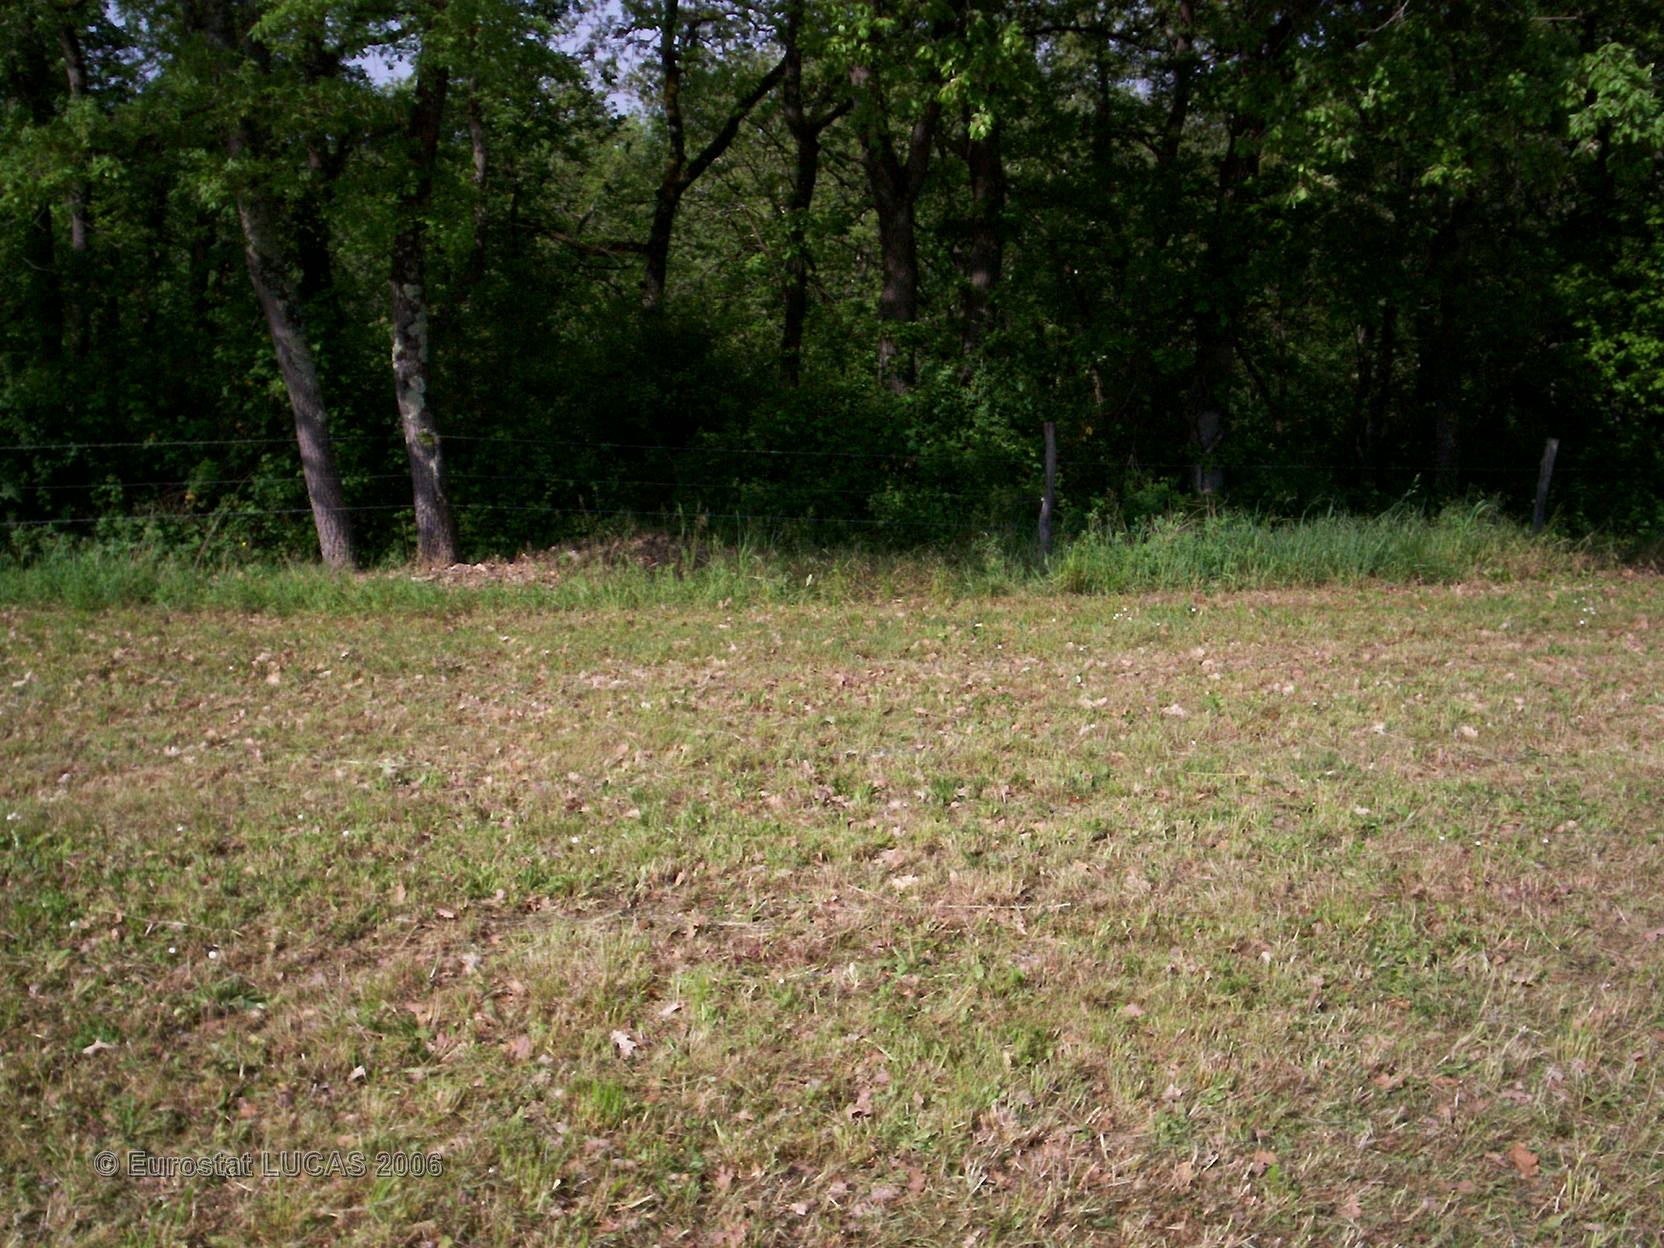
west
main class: Grassland
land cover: Grassland without tree/shrub cover
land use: Agriculture (excluding fallow land and kitchen gardens)
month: May
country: FR
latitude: 43.8187
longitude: 0.2594
